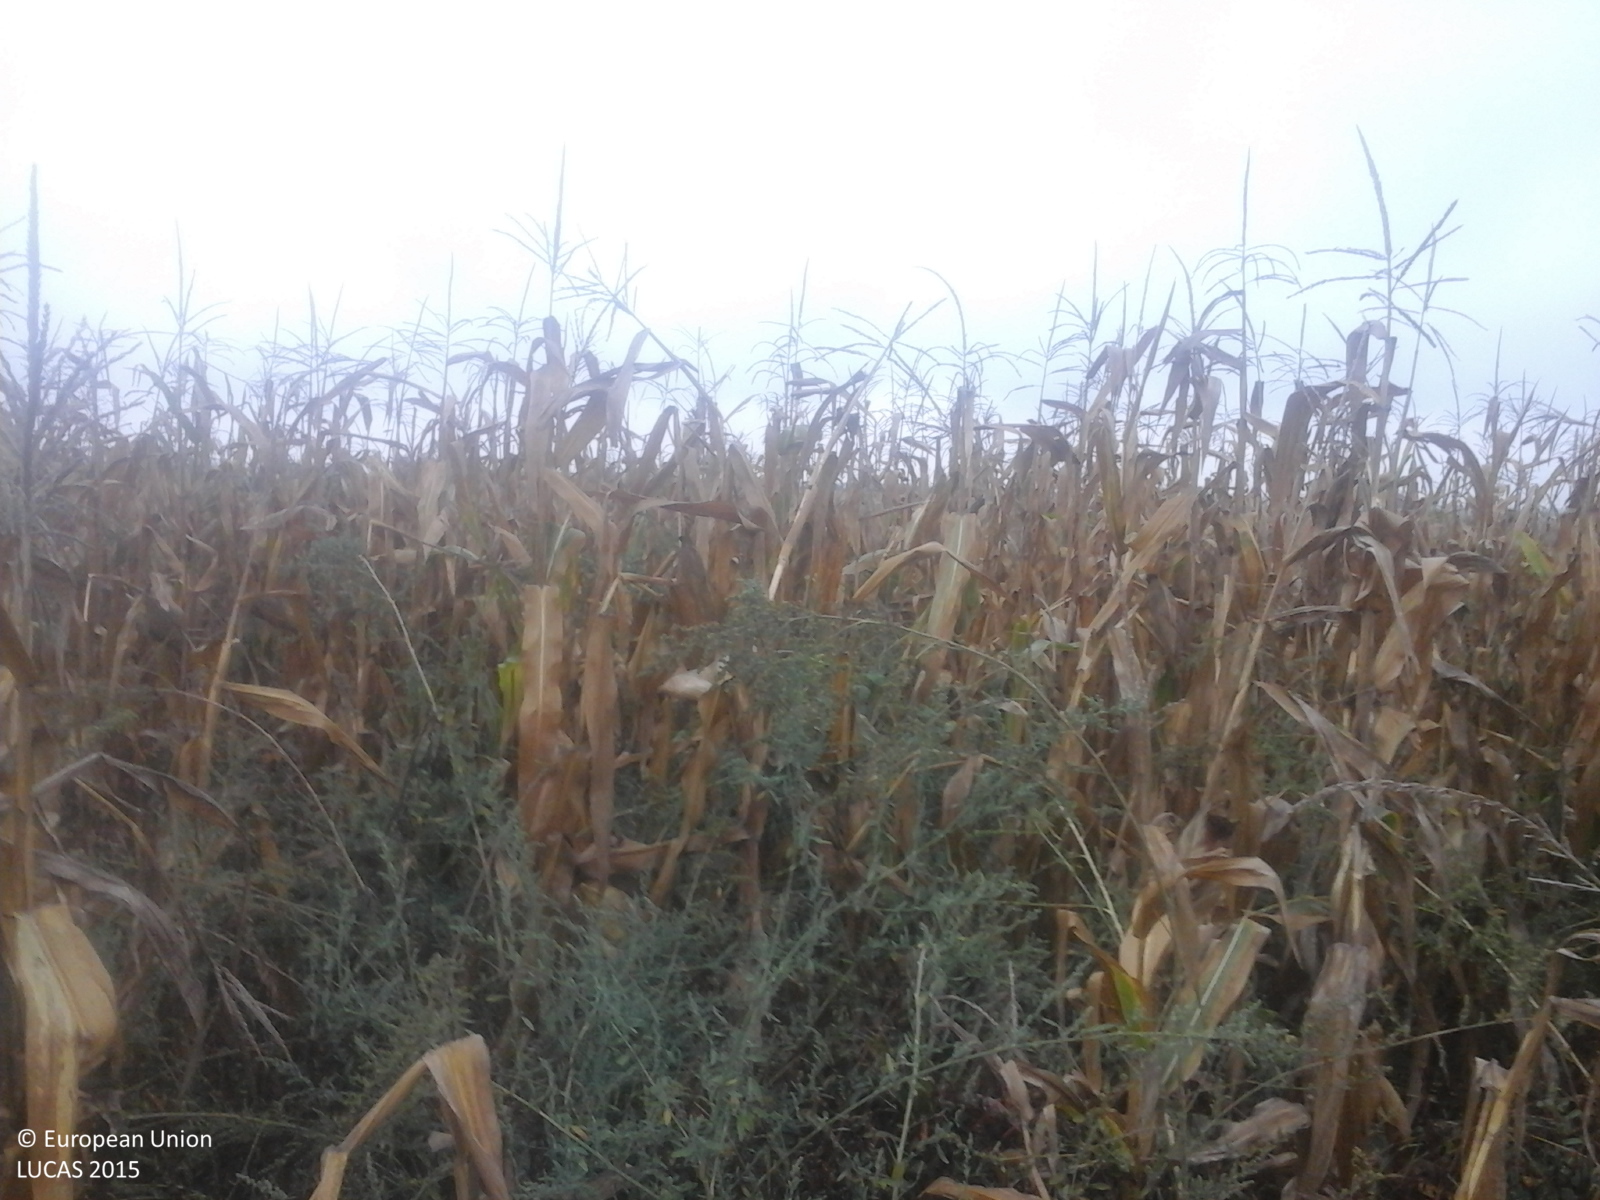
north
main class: Cropland
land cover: Maize
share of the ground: > 75 %
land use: Agriculture (excluding fallow land and kitchen gardens)
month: September
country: RO
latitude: 45.8250
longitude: 22.1028
